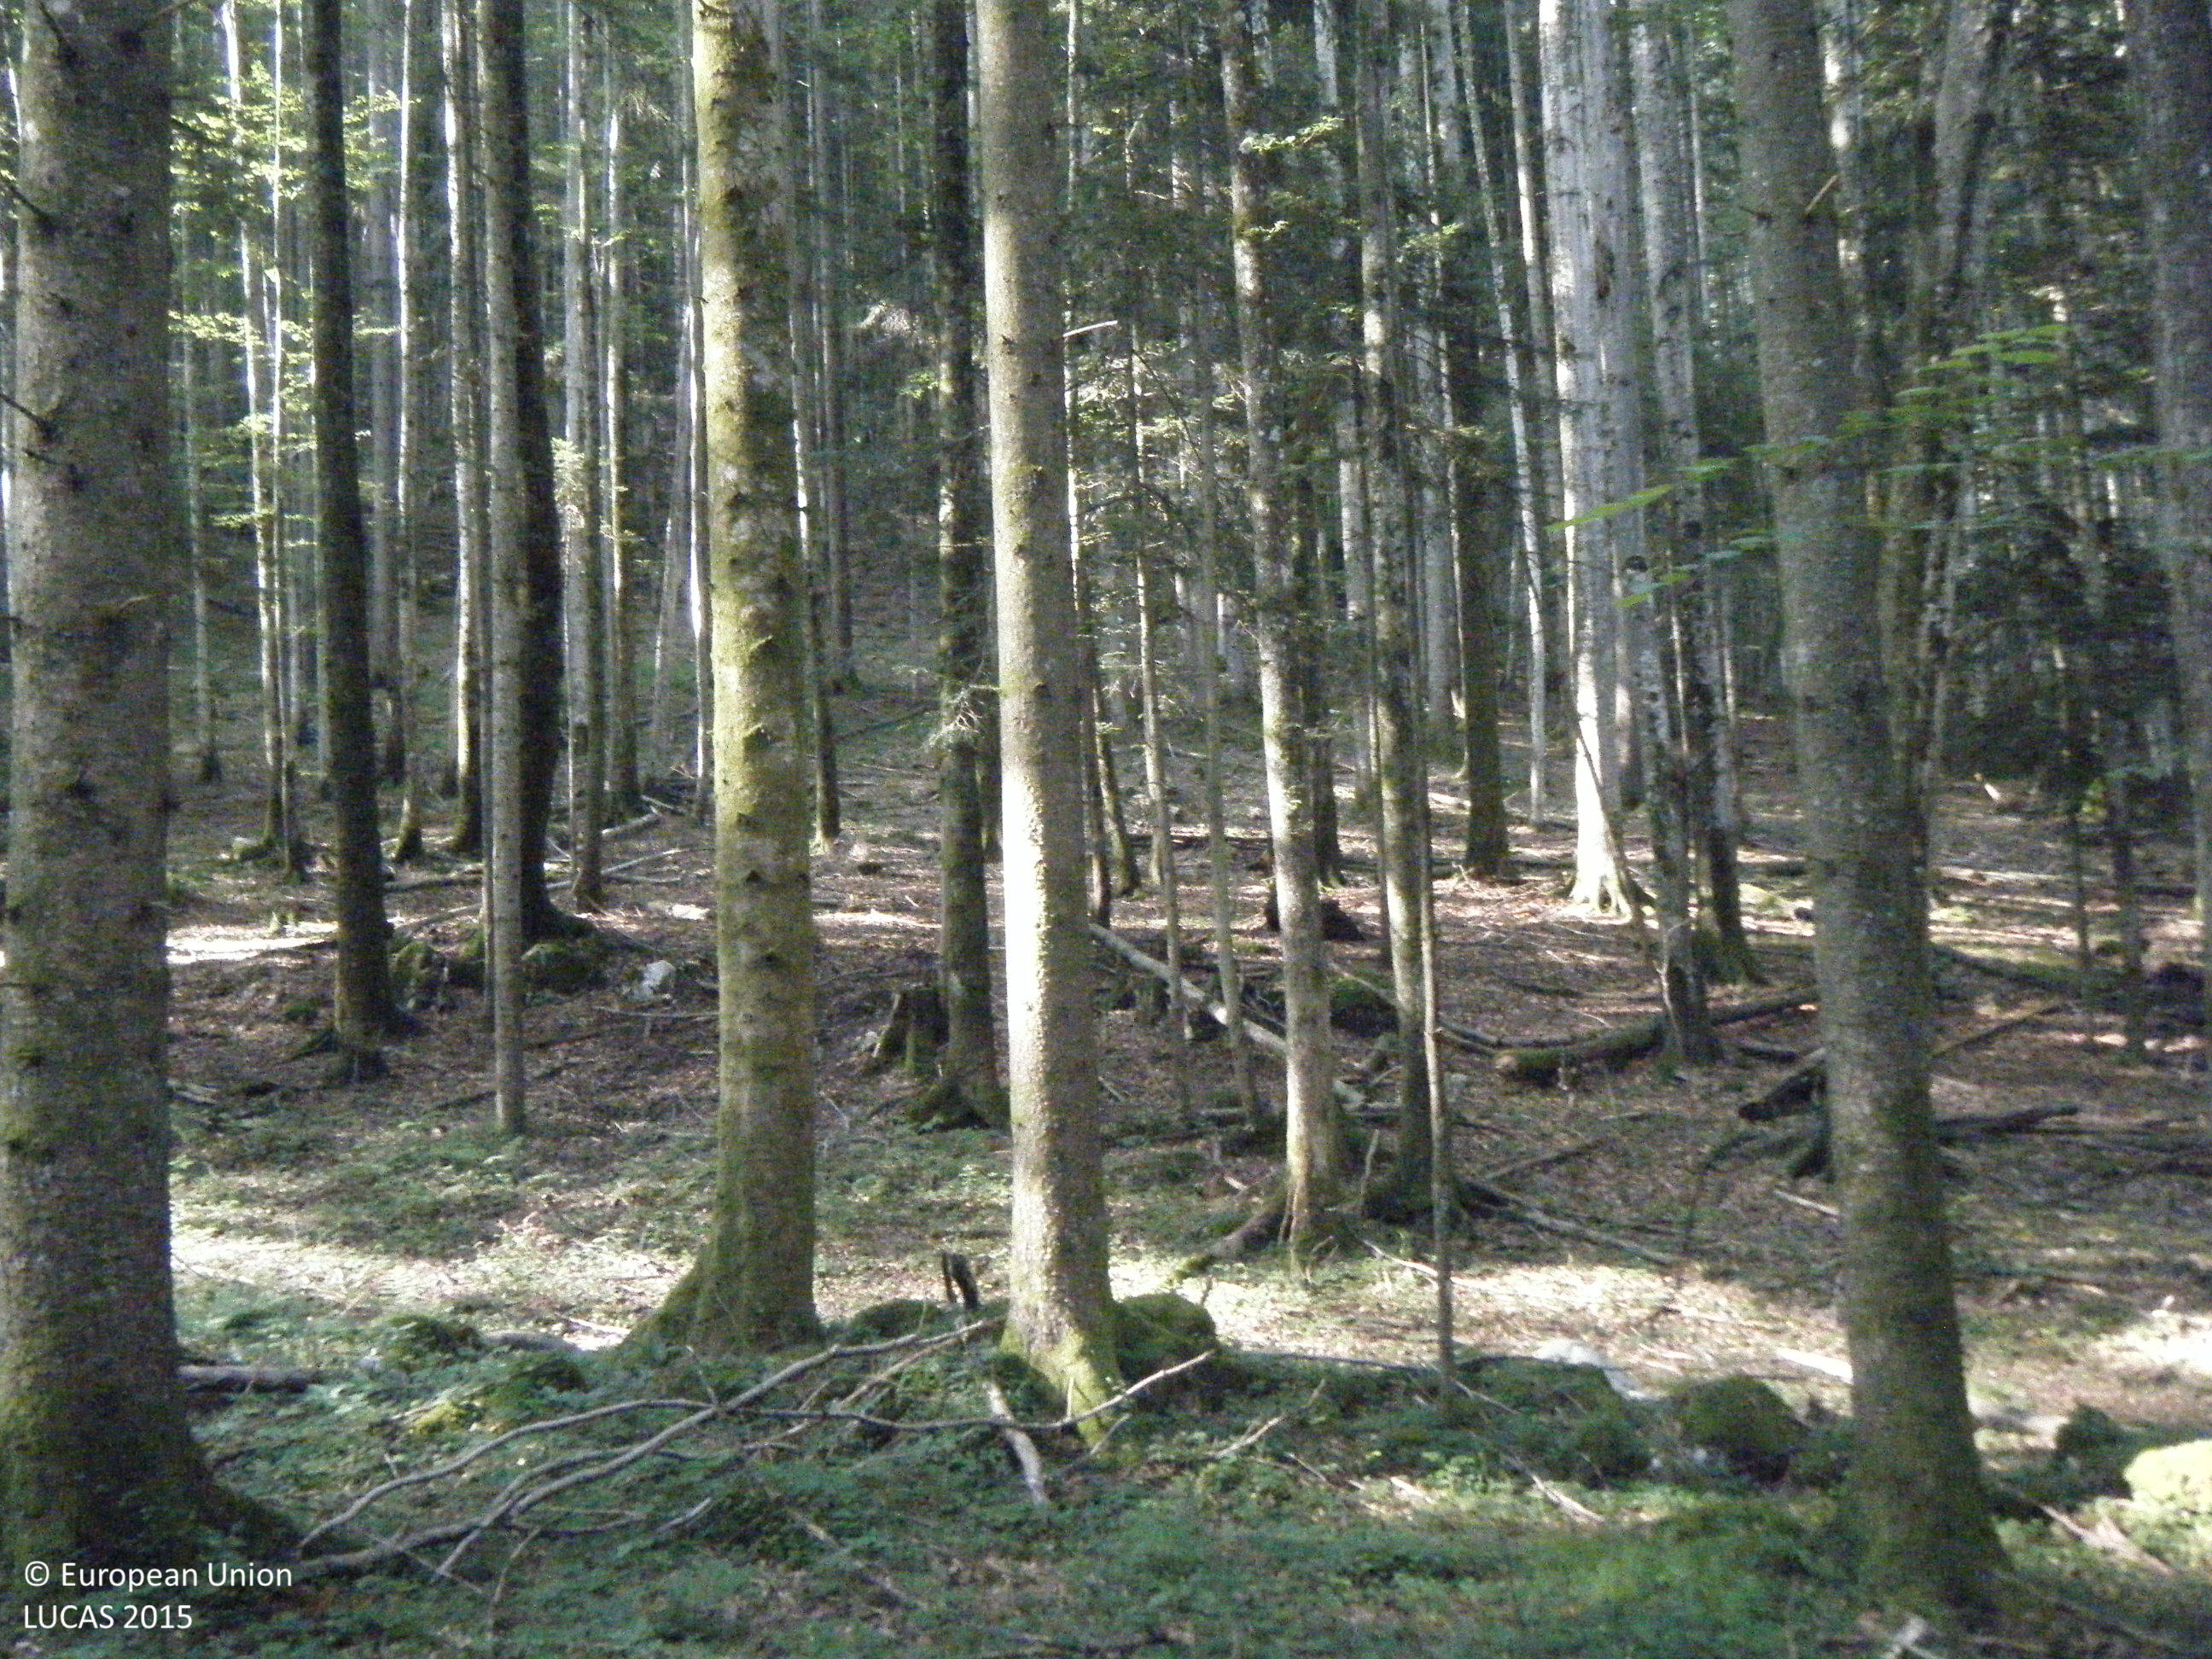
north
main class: Woodland
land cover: Spruce dominated mixed woodland
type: alpine coniferous forest
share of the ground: > 75 %
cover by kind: coniferous forest trees 55 %, broadleaved forest trees 25 %, herbaceous plants 15 %, lichens and mosses 5 %
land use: Forestry
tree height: > 5 m
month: July
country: AT
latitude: 47.7364
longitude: 13.4791
